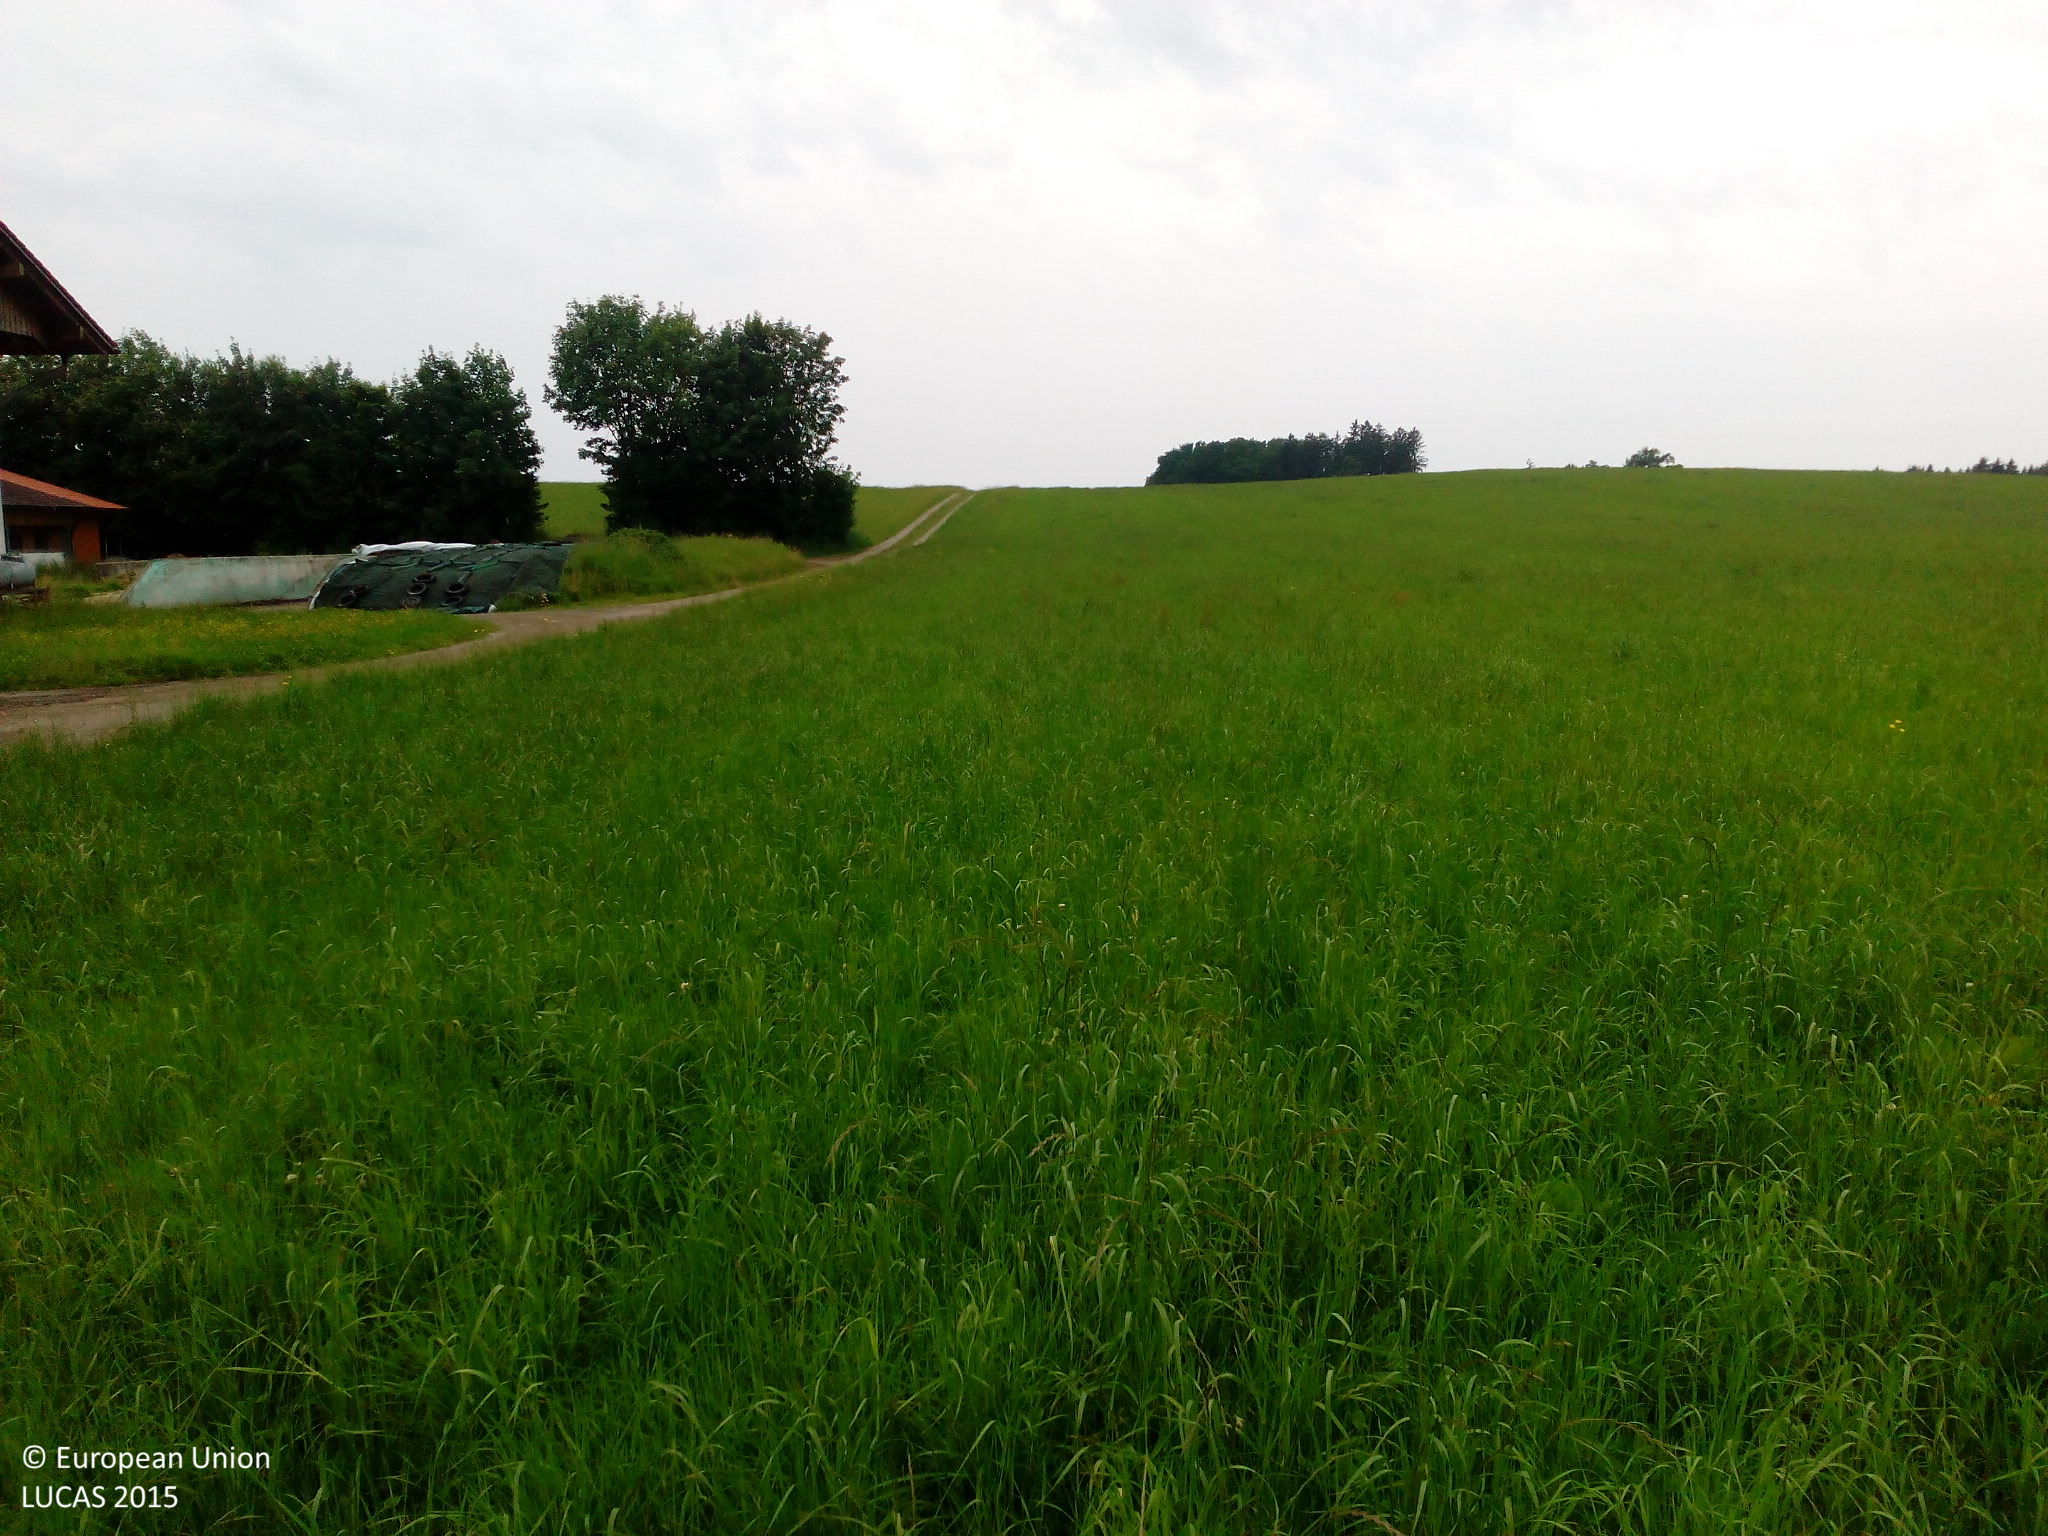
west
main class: Grassland
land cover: Grassland without tree/shrub cover
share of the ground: > 75 %
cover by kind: herbaceous plants 100 %
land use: Agriculture (excluding fallow land and kitchen gardens)
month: June
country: DE
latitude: 47.9090
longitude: 11.3771
